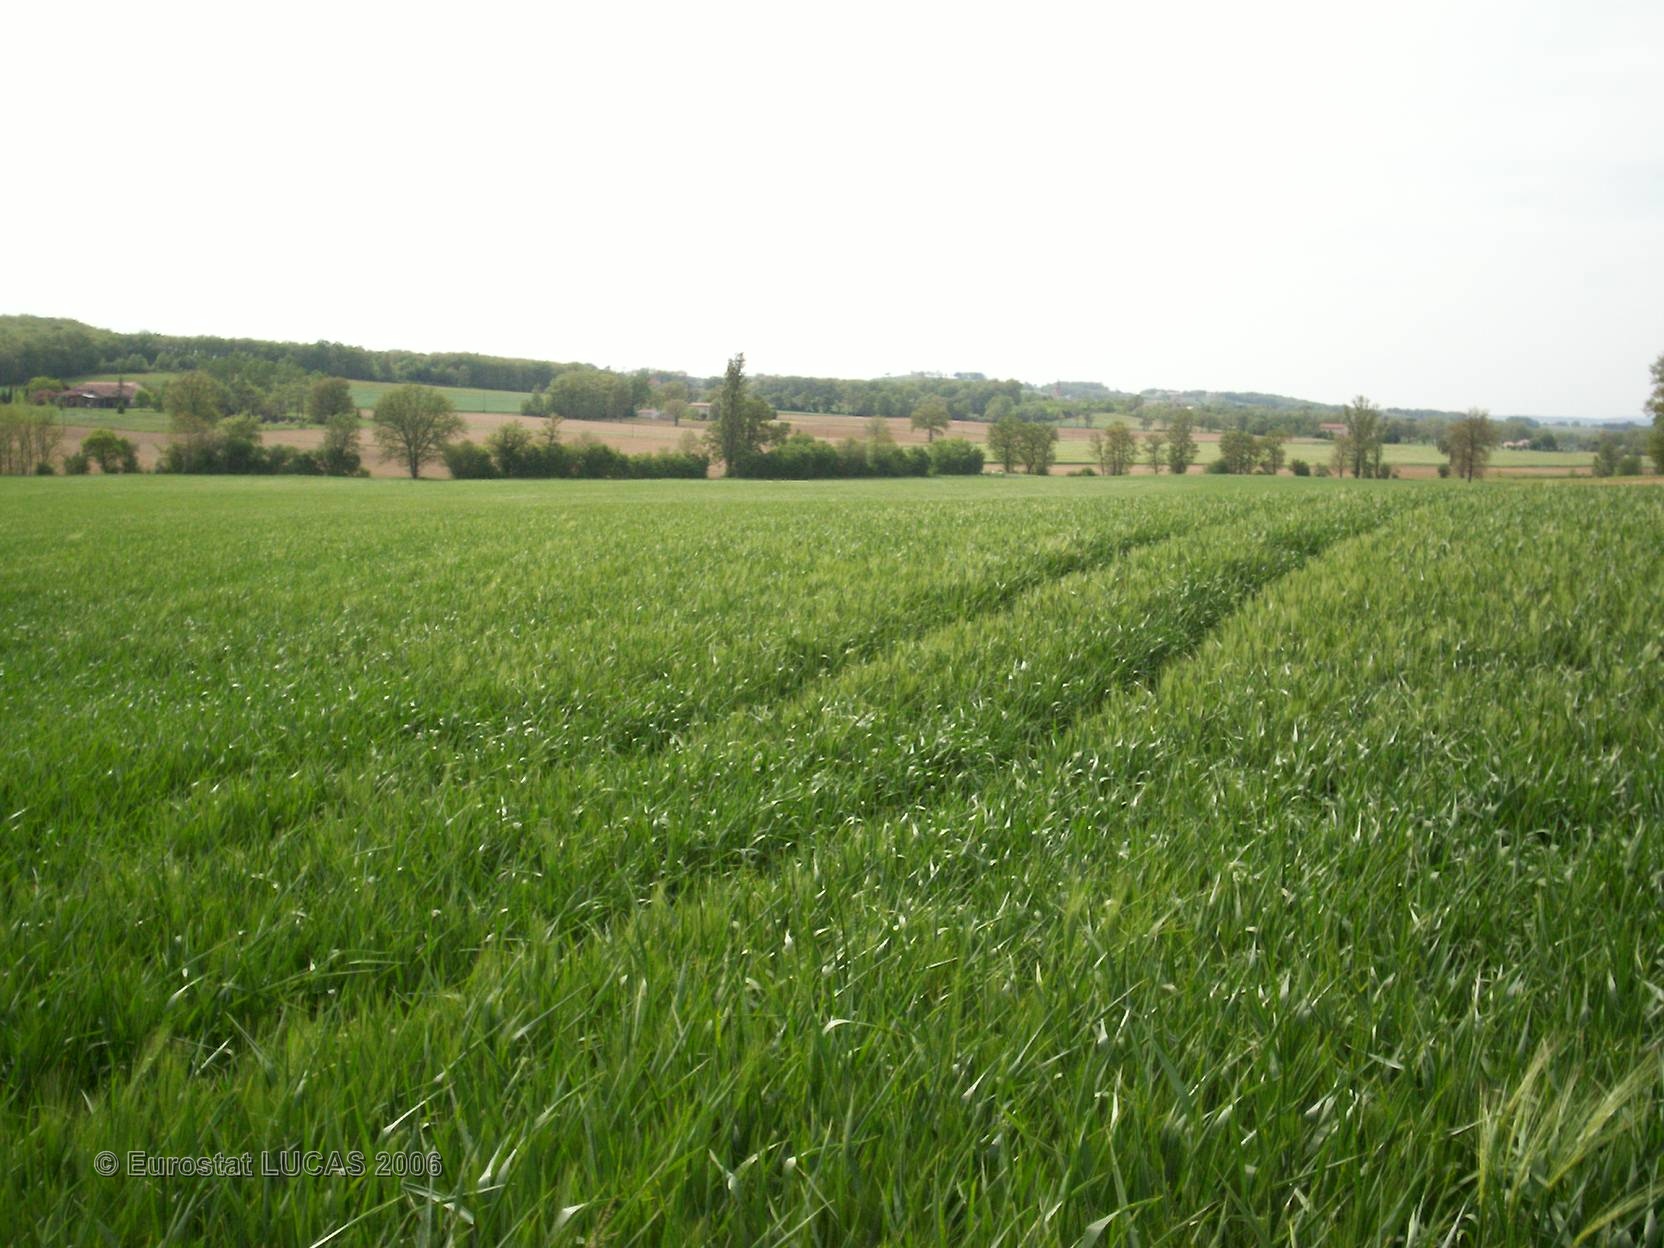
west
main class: Cropland
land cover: Durum wheat
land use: Agriculture (excluding fallow land and kitchen gardens)
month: May
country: FR
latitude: 43.8425
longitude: 2.0061
